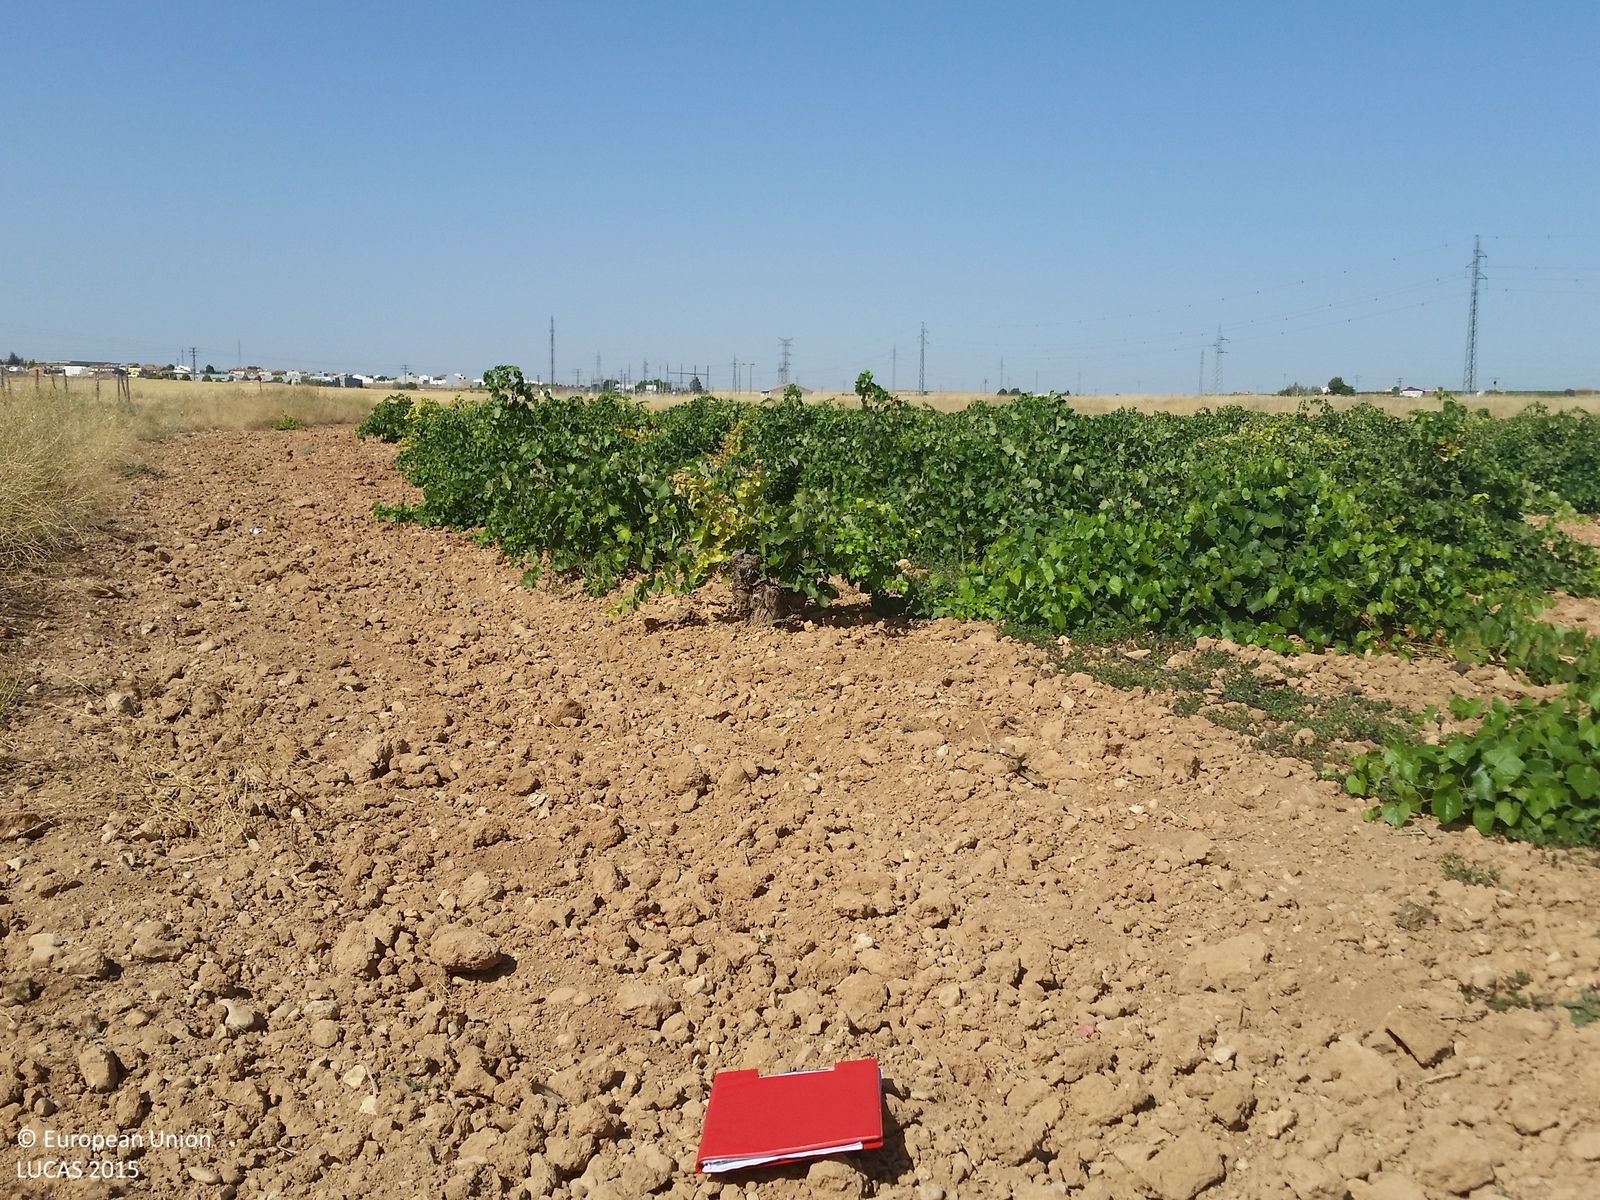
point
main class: Cropland
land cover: Vineyards
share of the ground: 50 - 75 %
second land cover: Other bare soil
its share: > 75 %
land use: Agriculture (excluding fallow land and kitchen gardens)
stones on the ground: 10 - 25 %
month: July
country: ES
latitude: 39.2882
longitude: -2.5896
